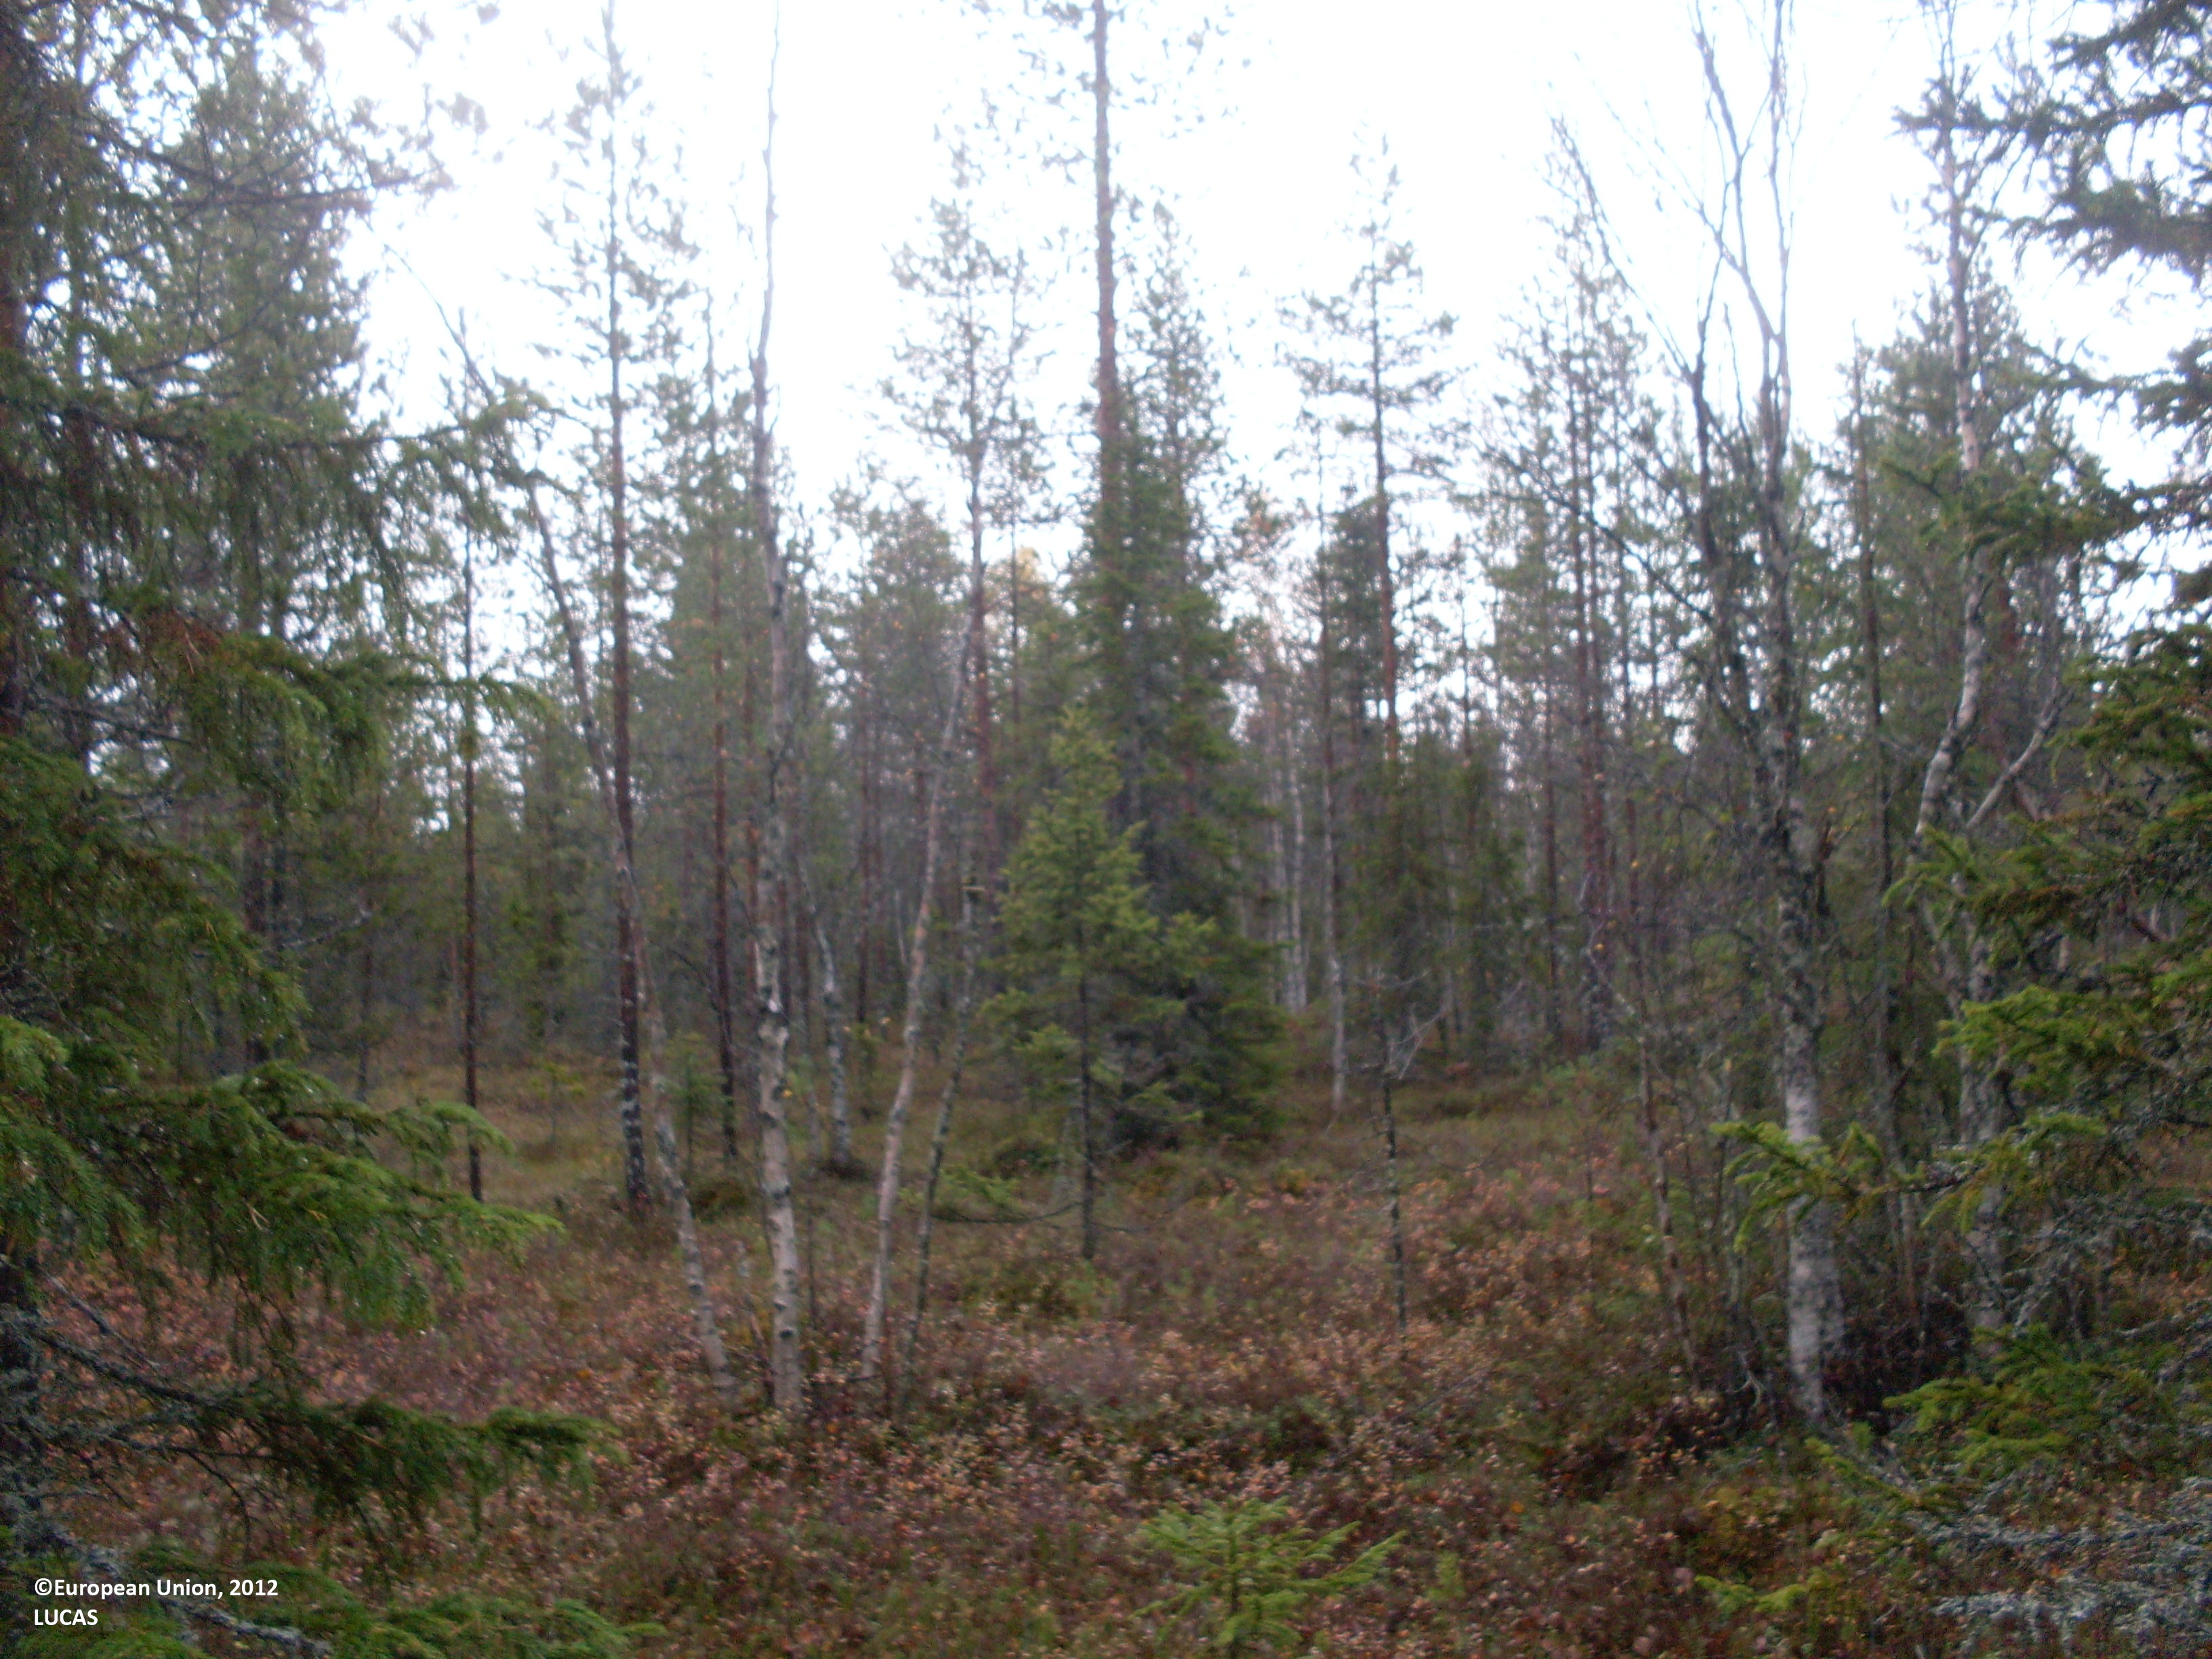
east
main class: Woodland
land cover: Pine dominated mixed woodland
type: boreal forest
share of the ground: 25 - 50 %
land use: Forestry
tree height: > 5 m
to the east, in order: Pine dominated mixed woodland; Ditches and canals; Pine dominated mixed woodland; Ditches and canals; Pine dominated mixed woodland
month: September
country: FI
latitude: 64.4616
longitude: 28.5779
